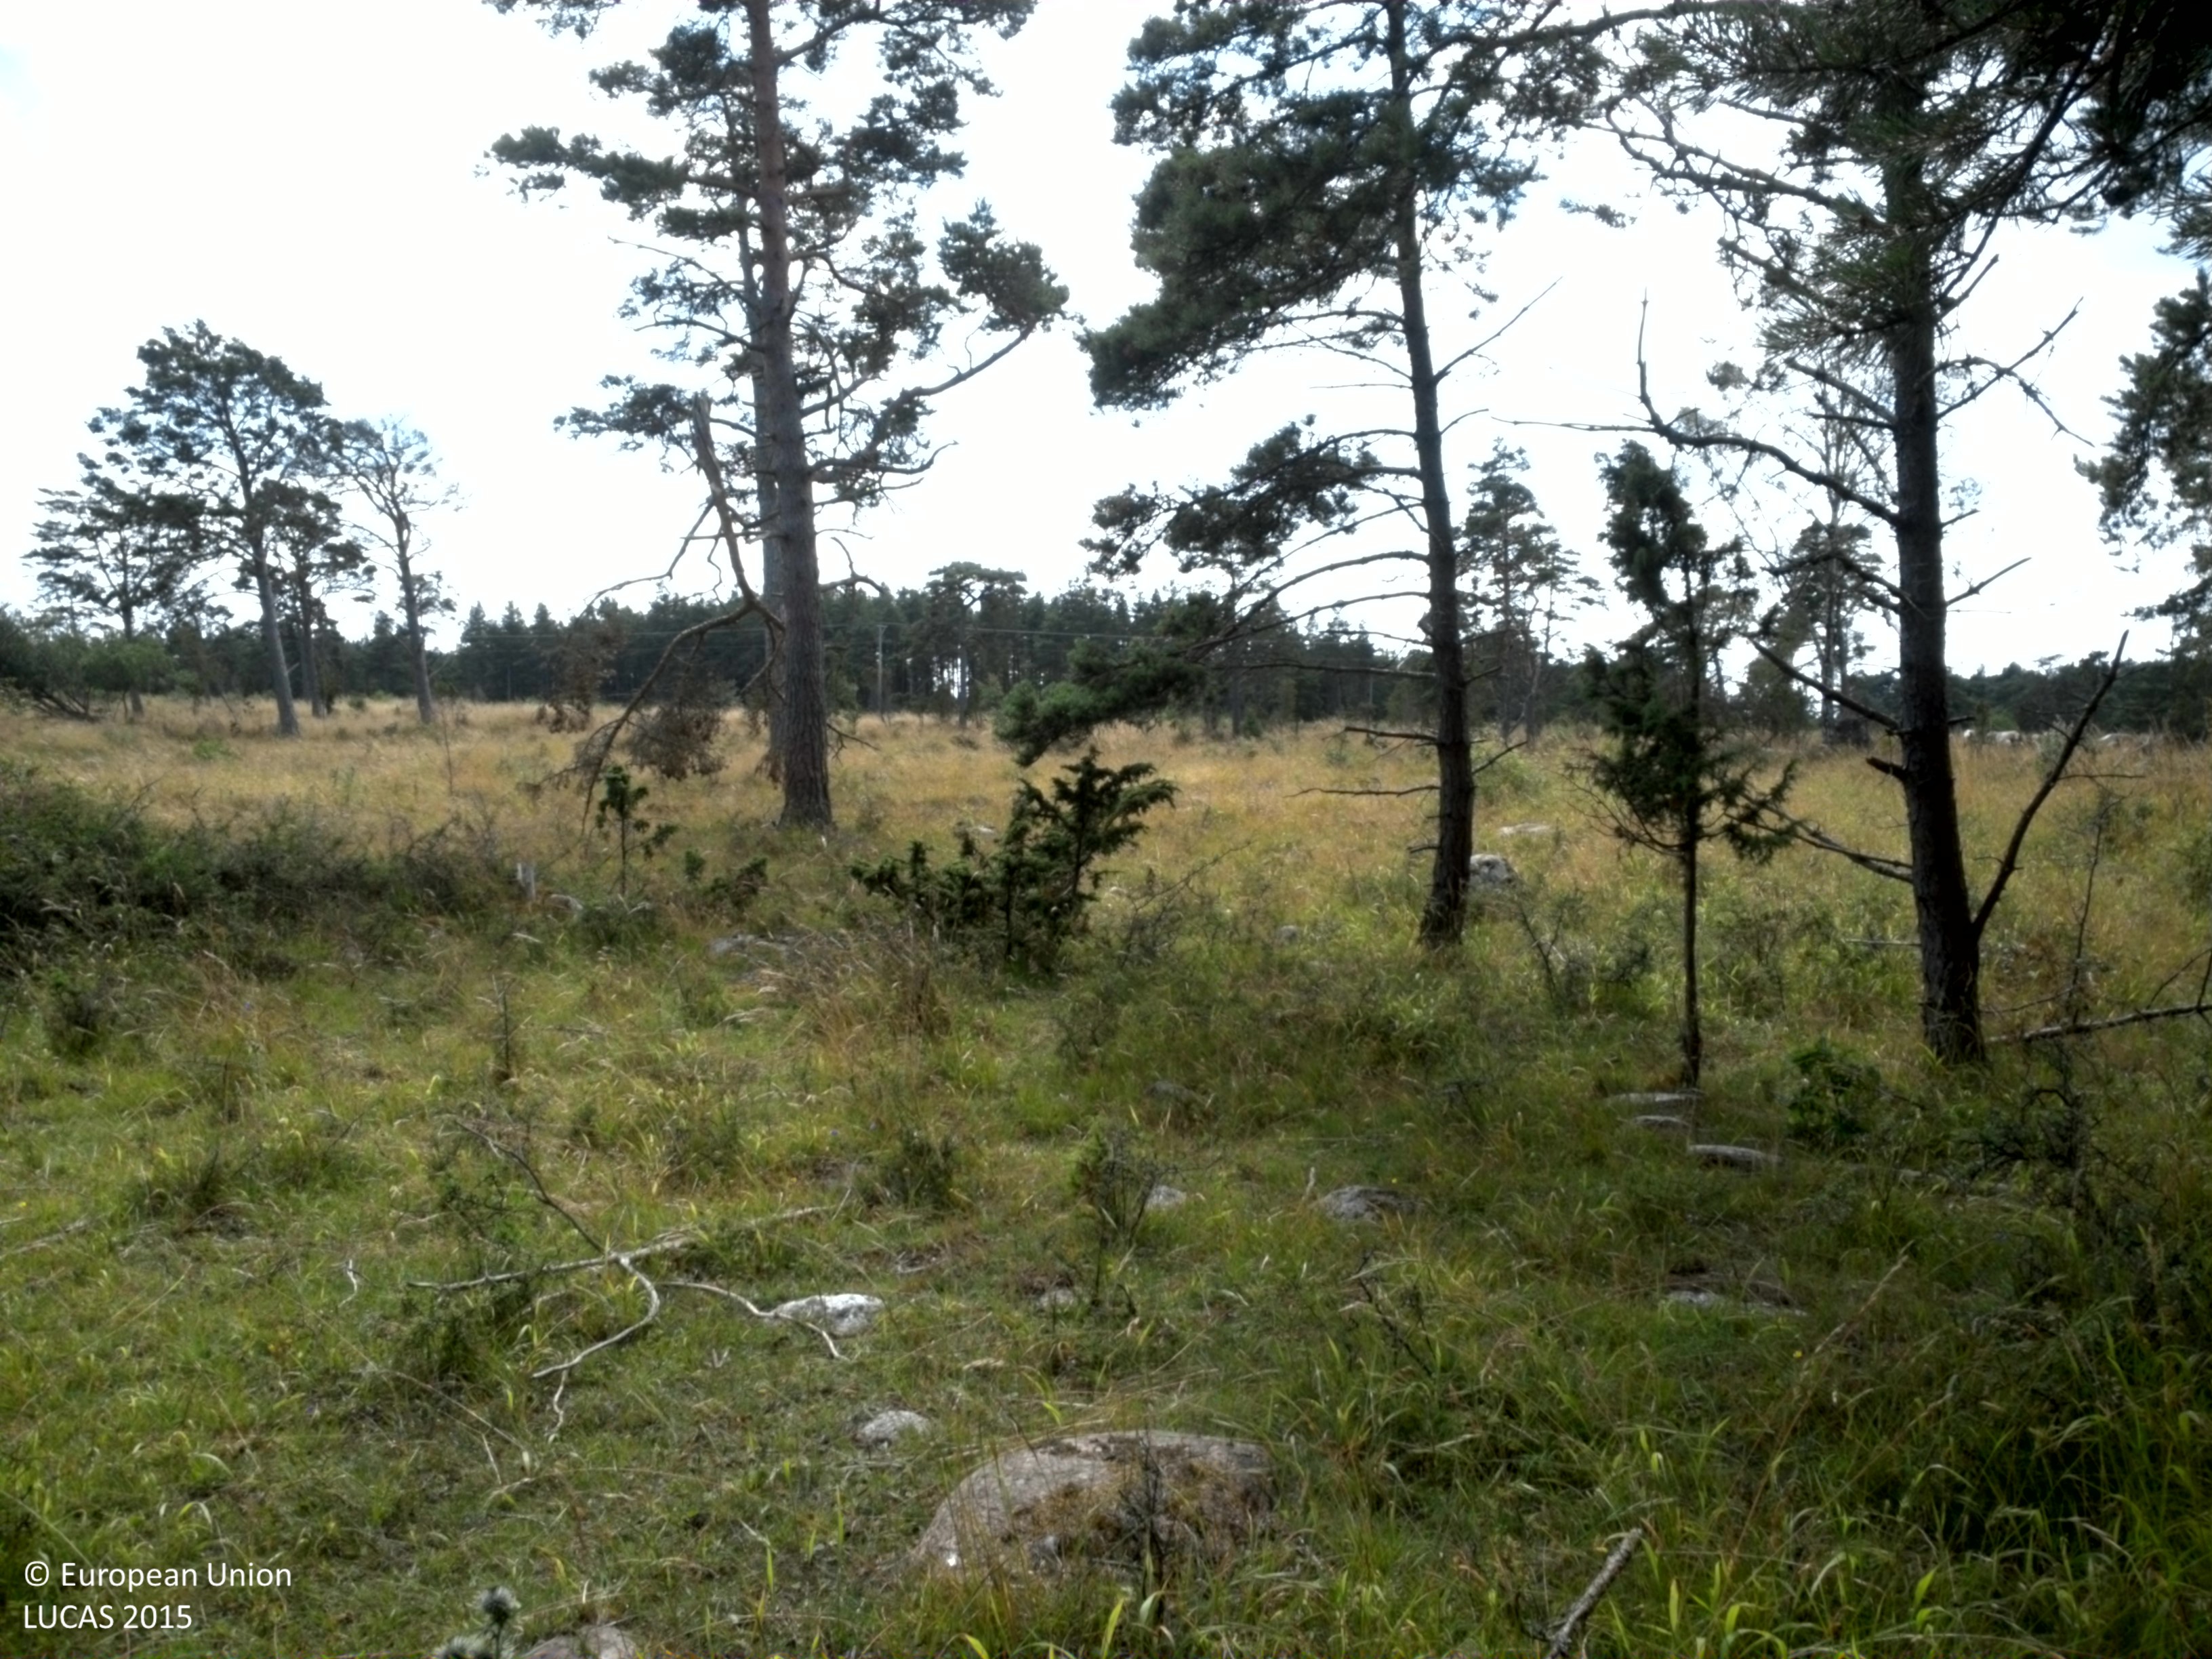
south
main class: Woodland
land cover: Pine dominated coniferous woodland
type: hemiboreal forest and nemoral coniferous forest and mixed broadleaved-coniferous forest
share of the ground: > 75 %
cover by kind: coniferous forest trees 75 %, herbaceous plants 15 %, shrubs 10 %
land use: Forestry
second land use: Agriculture (excluding fallow land and kitchen gardens)
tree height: > 5 m
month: July
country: SE
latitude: 57.1553
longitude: 18.1911
